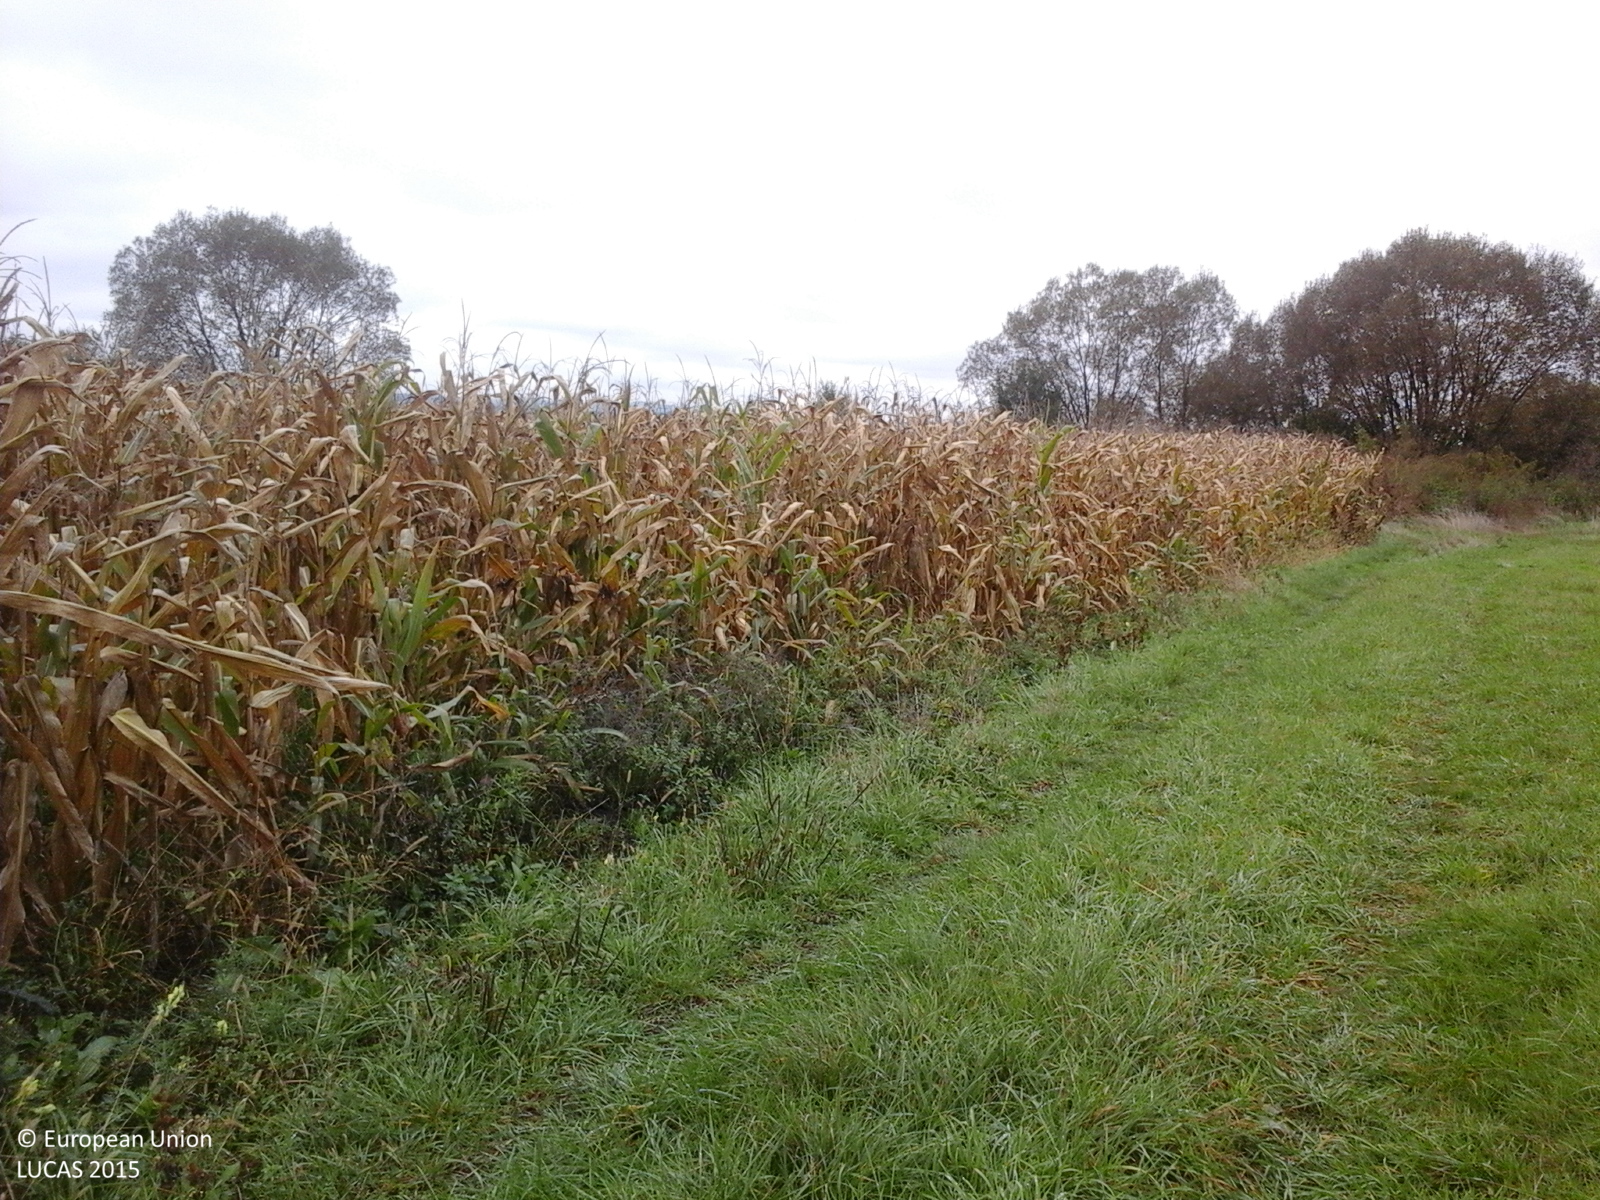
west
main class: Cropland
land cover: Maize
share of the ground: > 75 %
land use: Agriculture (excluding fallow land and kitchen gardens)
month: October
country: RO
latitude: 45.8293
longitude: 24.1188
